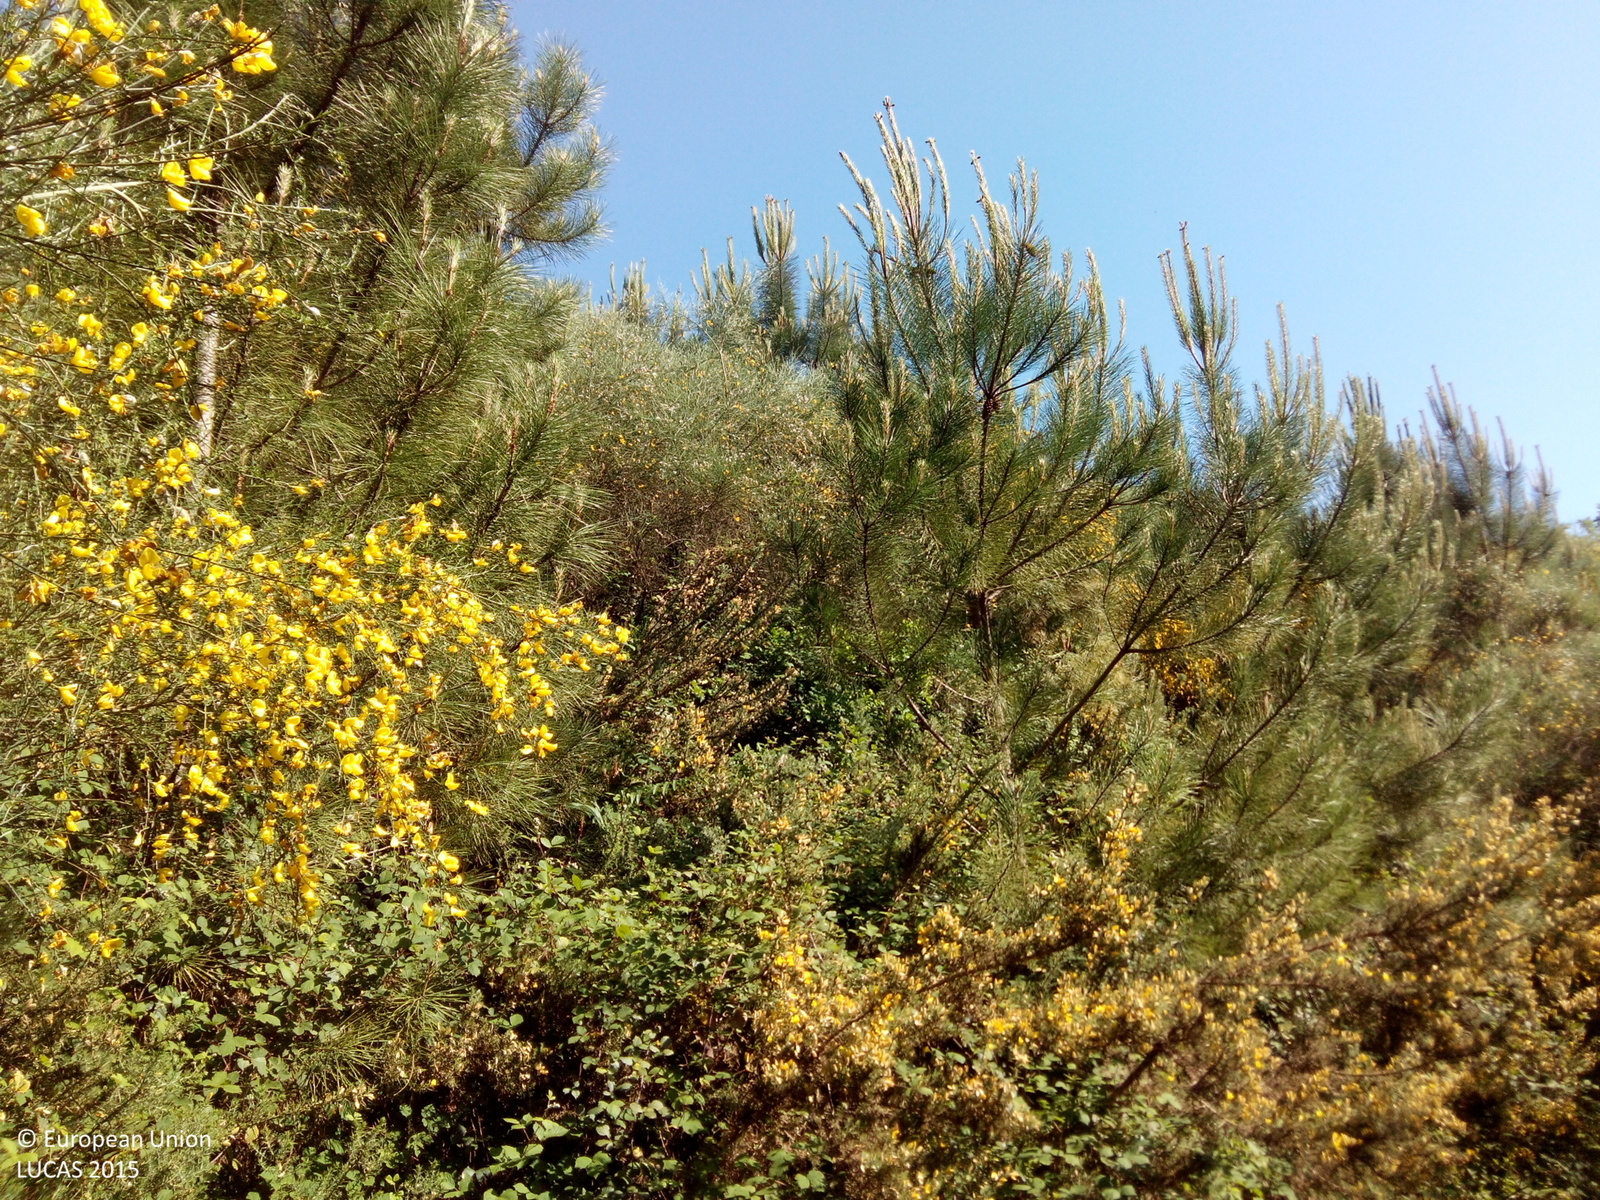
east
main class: Woodland
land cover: Pine dominated coniferous woodland
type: hemiboreal forest and nemoral coniferous forest and mixed broadleaved-coniferous forest
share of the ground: > 75 %
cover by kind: coniferous forest trees 100 %
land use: Forestry
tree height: > 5 m
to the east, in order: Pine dominated coniferous woodland; Tracks; Shrubland with sparse tree cover; Tracks; Shrubland without tree cover; Rock outcrops; Dry stone walls; Grassland without tree/shrub cover; Dry stone walls; Shrubland with sparse tree cover
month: May
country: ES
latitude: 42.0851
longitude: -8.8531
